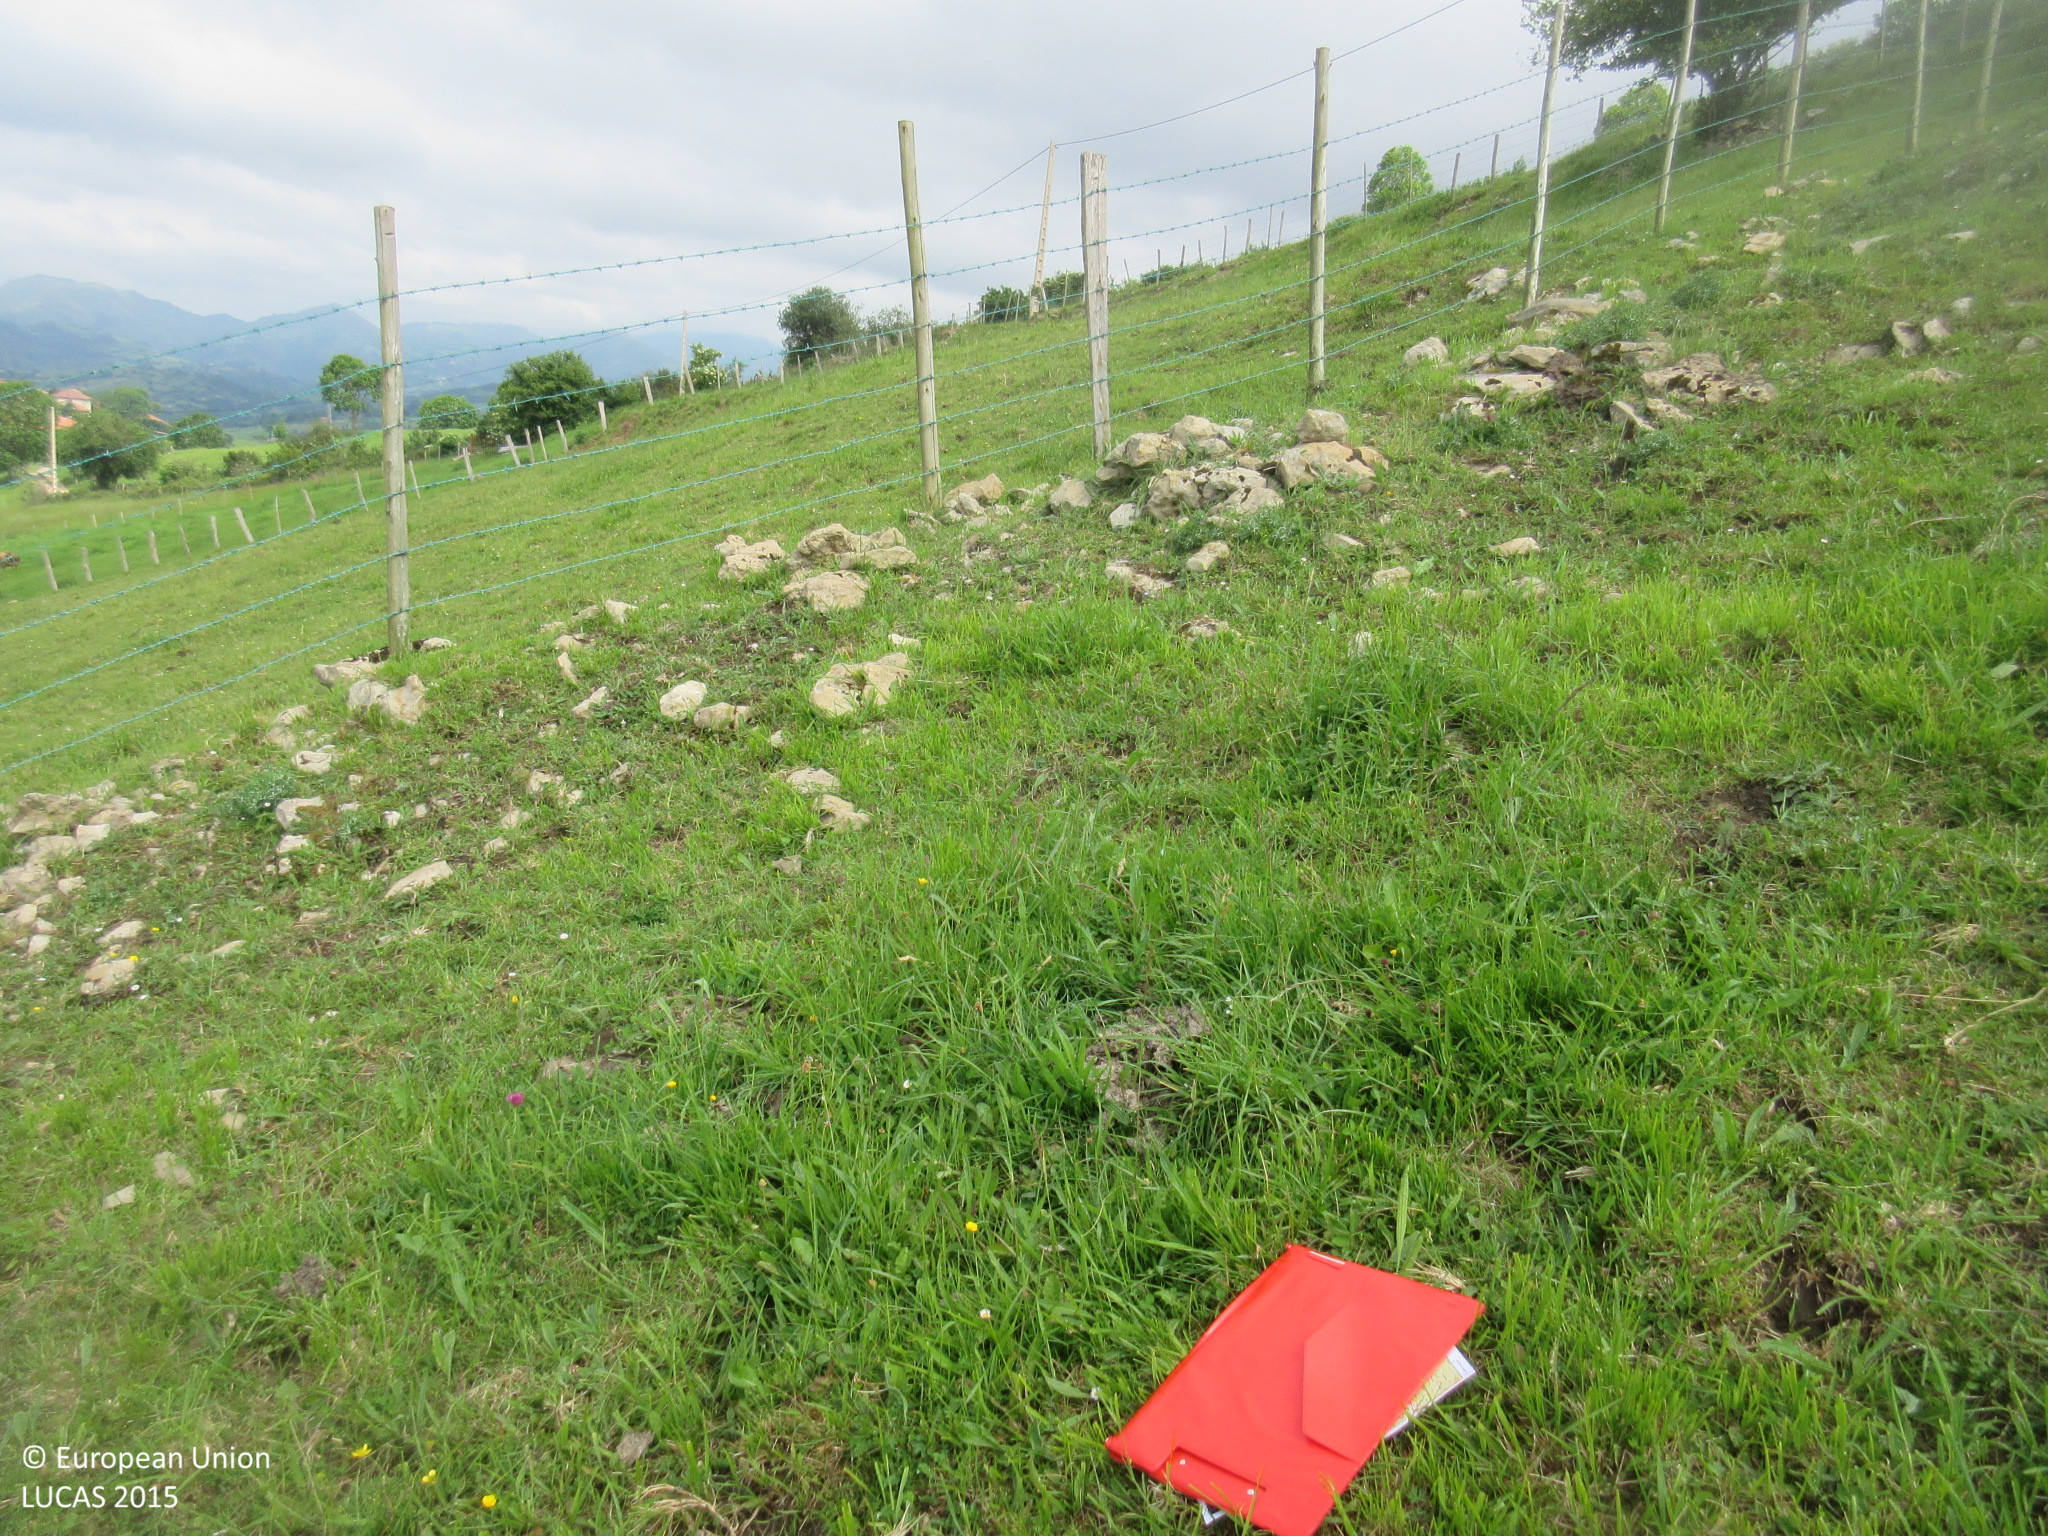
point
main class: Grassland
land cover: Grassland without tree/shrub cover
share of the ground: > 75 %
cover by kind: herbaceous plants 100 %
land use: Agriculture (excluding fallow land and kitchen gardens)
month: May
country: ES
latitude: 43.3187
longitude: -4.5492
